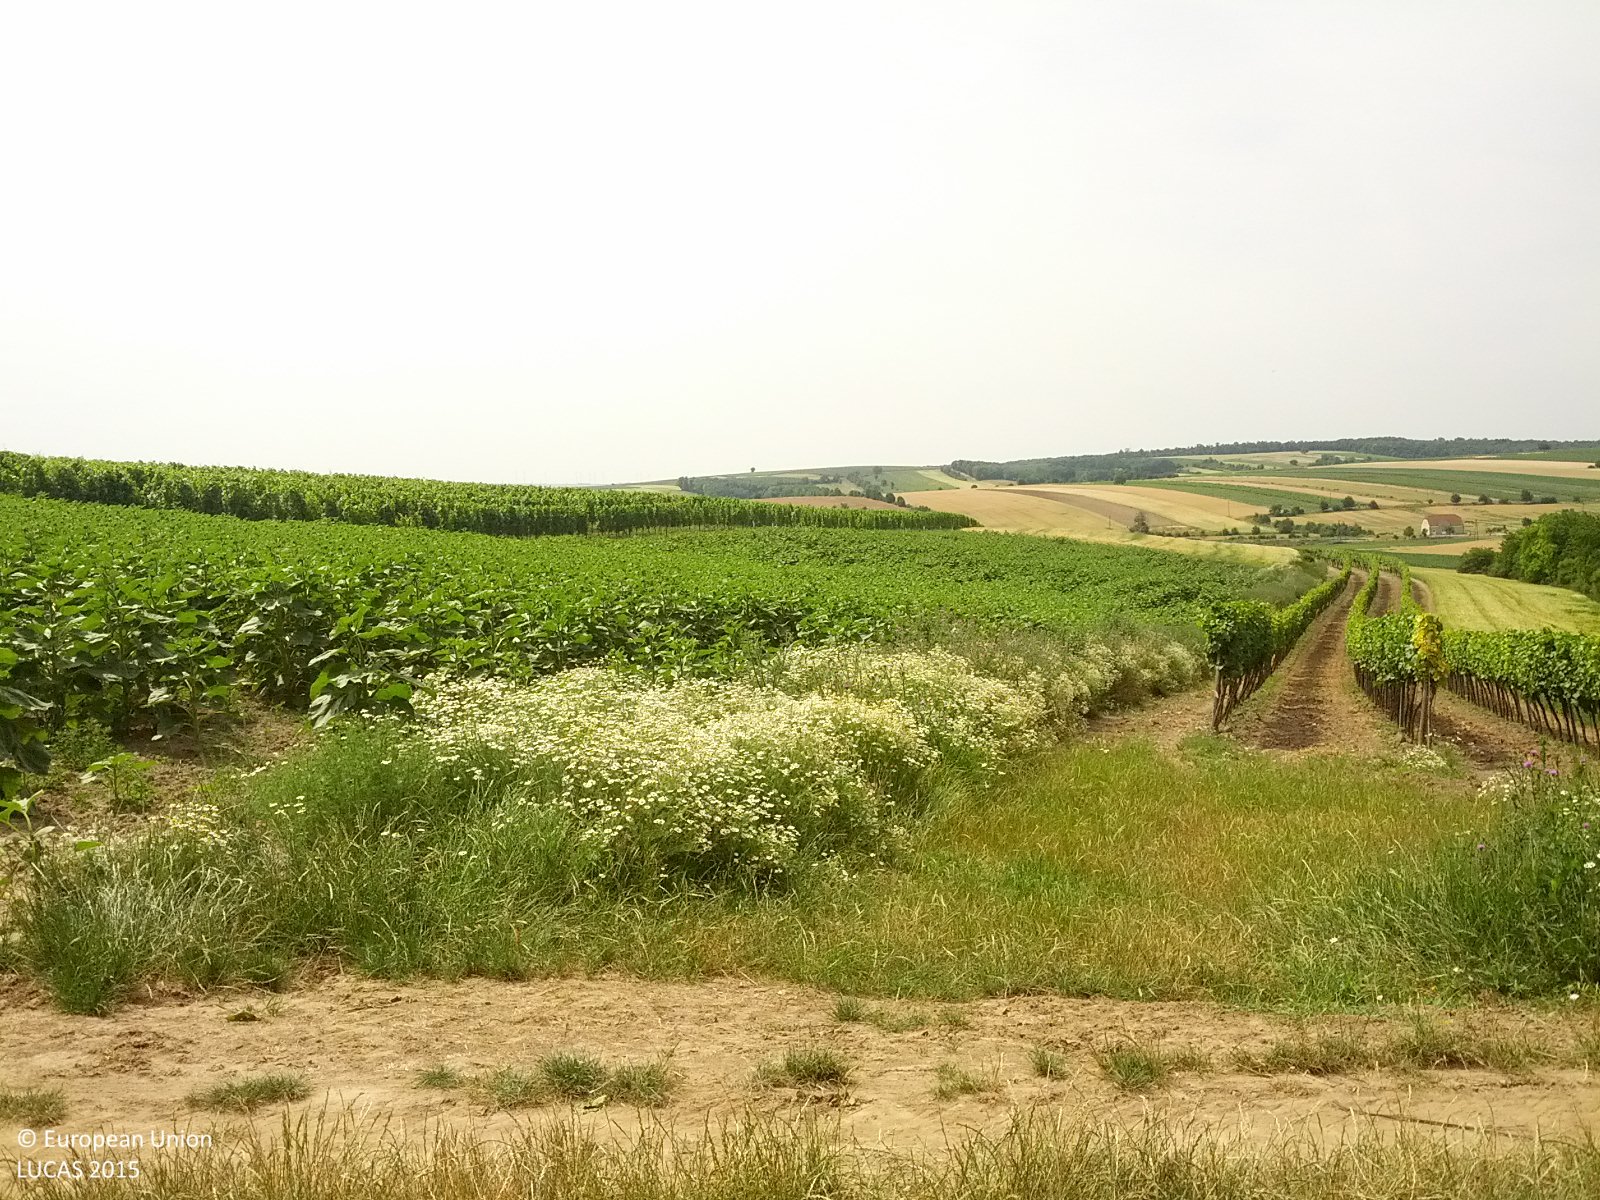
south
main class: Cropland
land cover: Vineyards
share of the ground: 10 - 25 %
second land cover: Other bare soil
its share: > 75 %
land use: Agriculture (excluding fallow land and kitchen gardens)
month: June
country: AT
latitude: 48.7053
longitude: 16.7064
